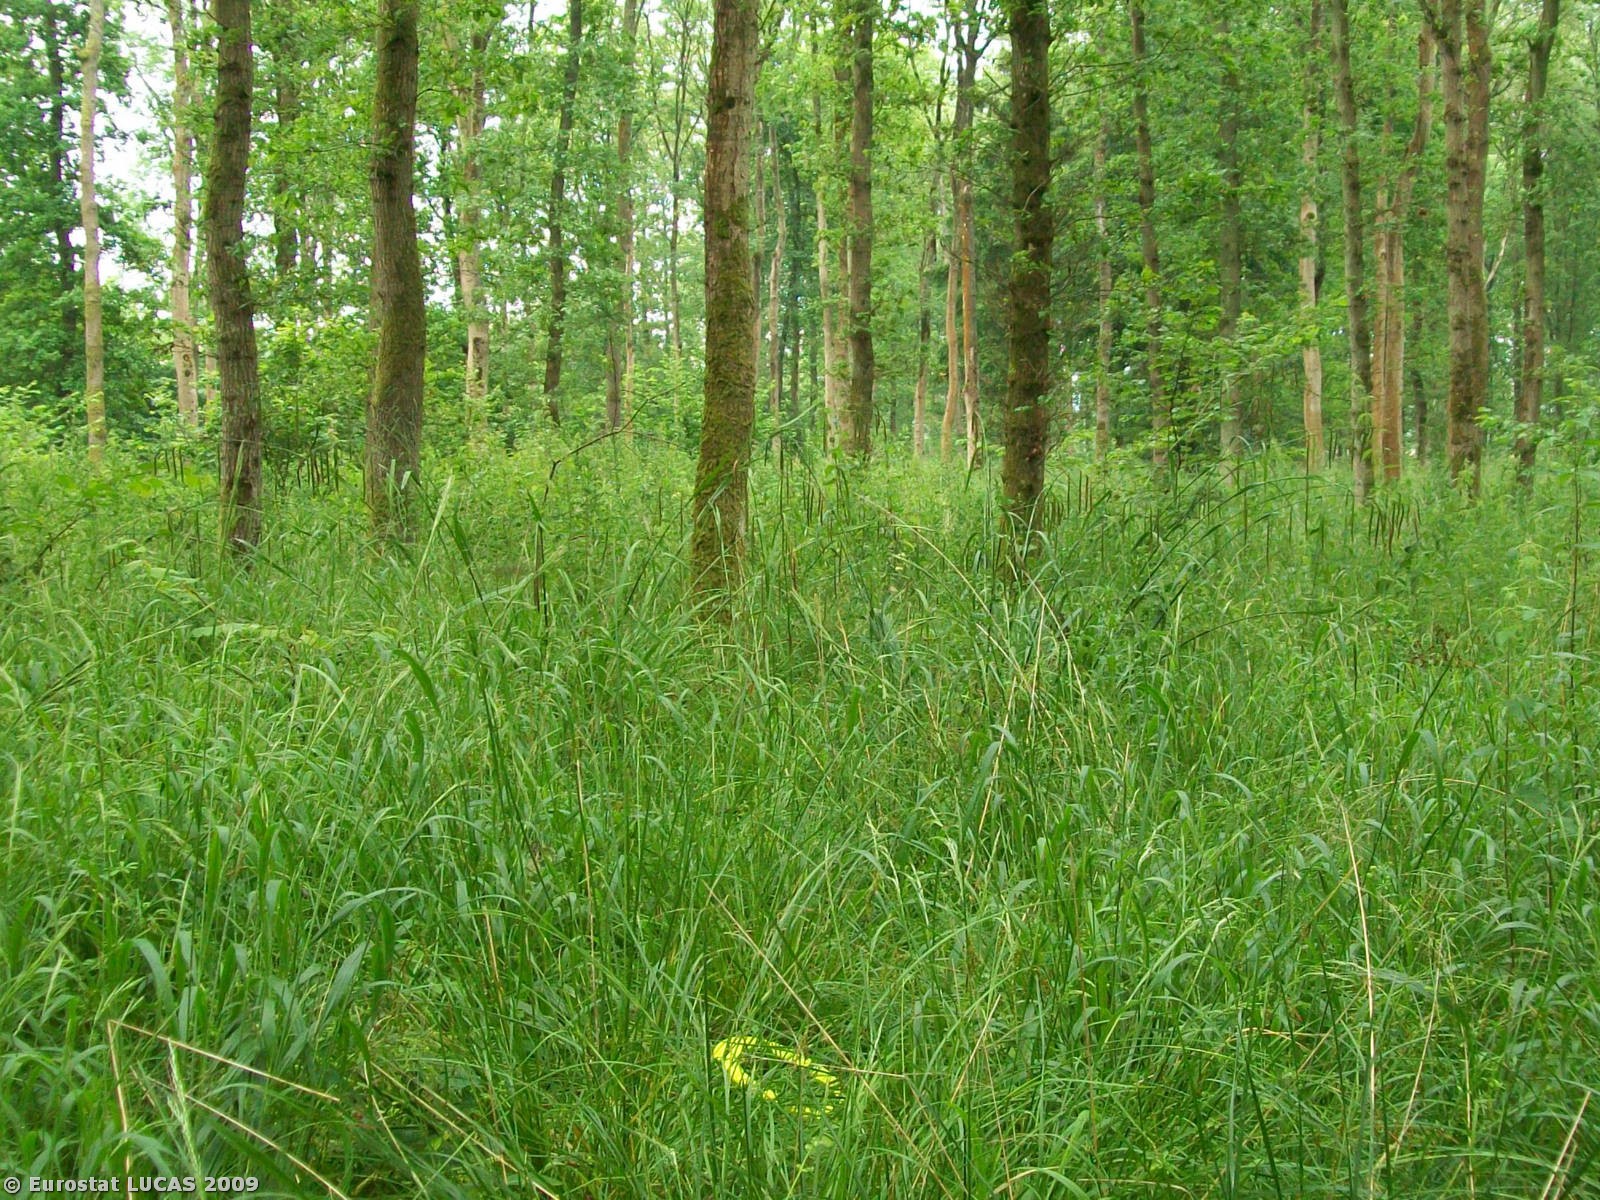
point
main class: Woodland
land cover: Broadleaved woodland
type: mesophytic deciduous forest
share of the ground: > 75 %
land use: Sport
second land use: Community services
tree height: > 5 m
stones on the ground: < 10 %
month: June
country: GB
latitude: 51.2161
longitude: -2.2165
